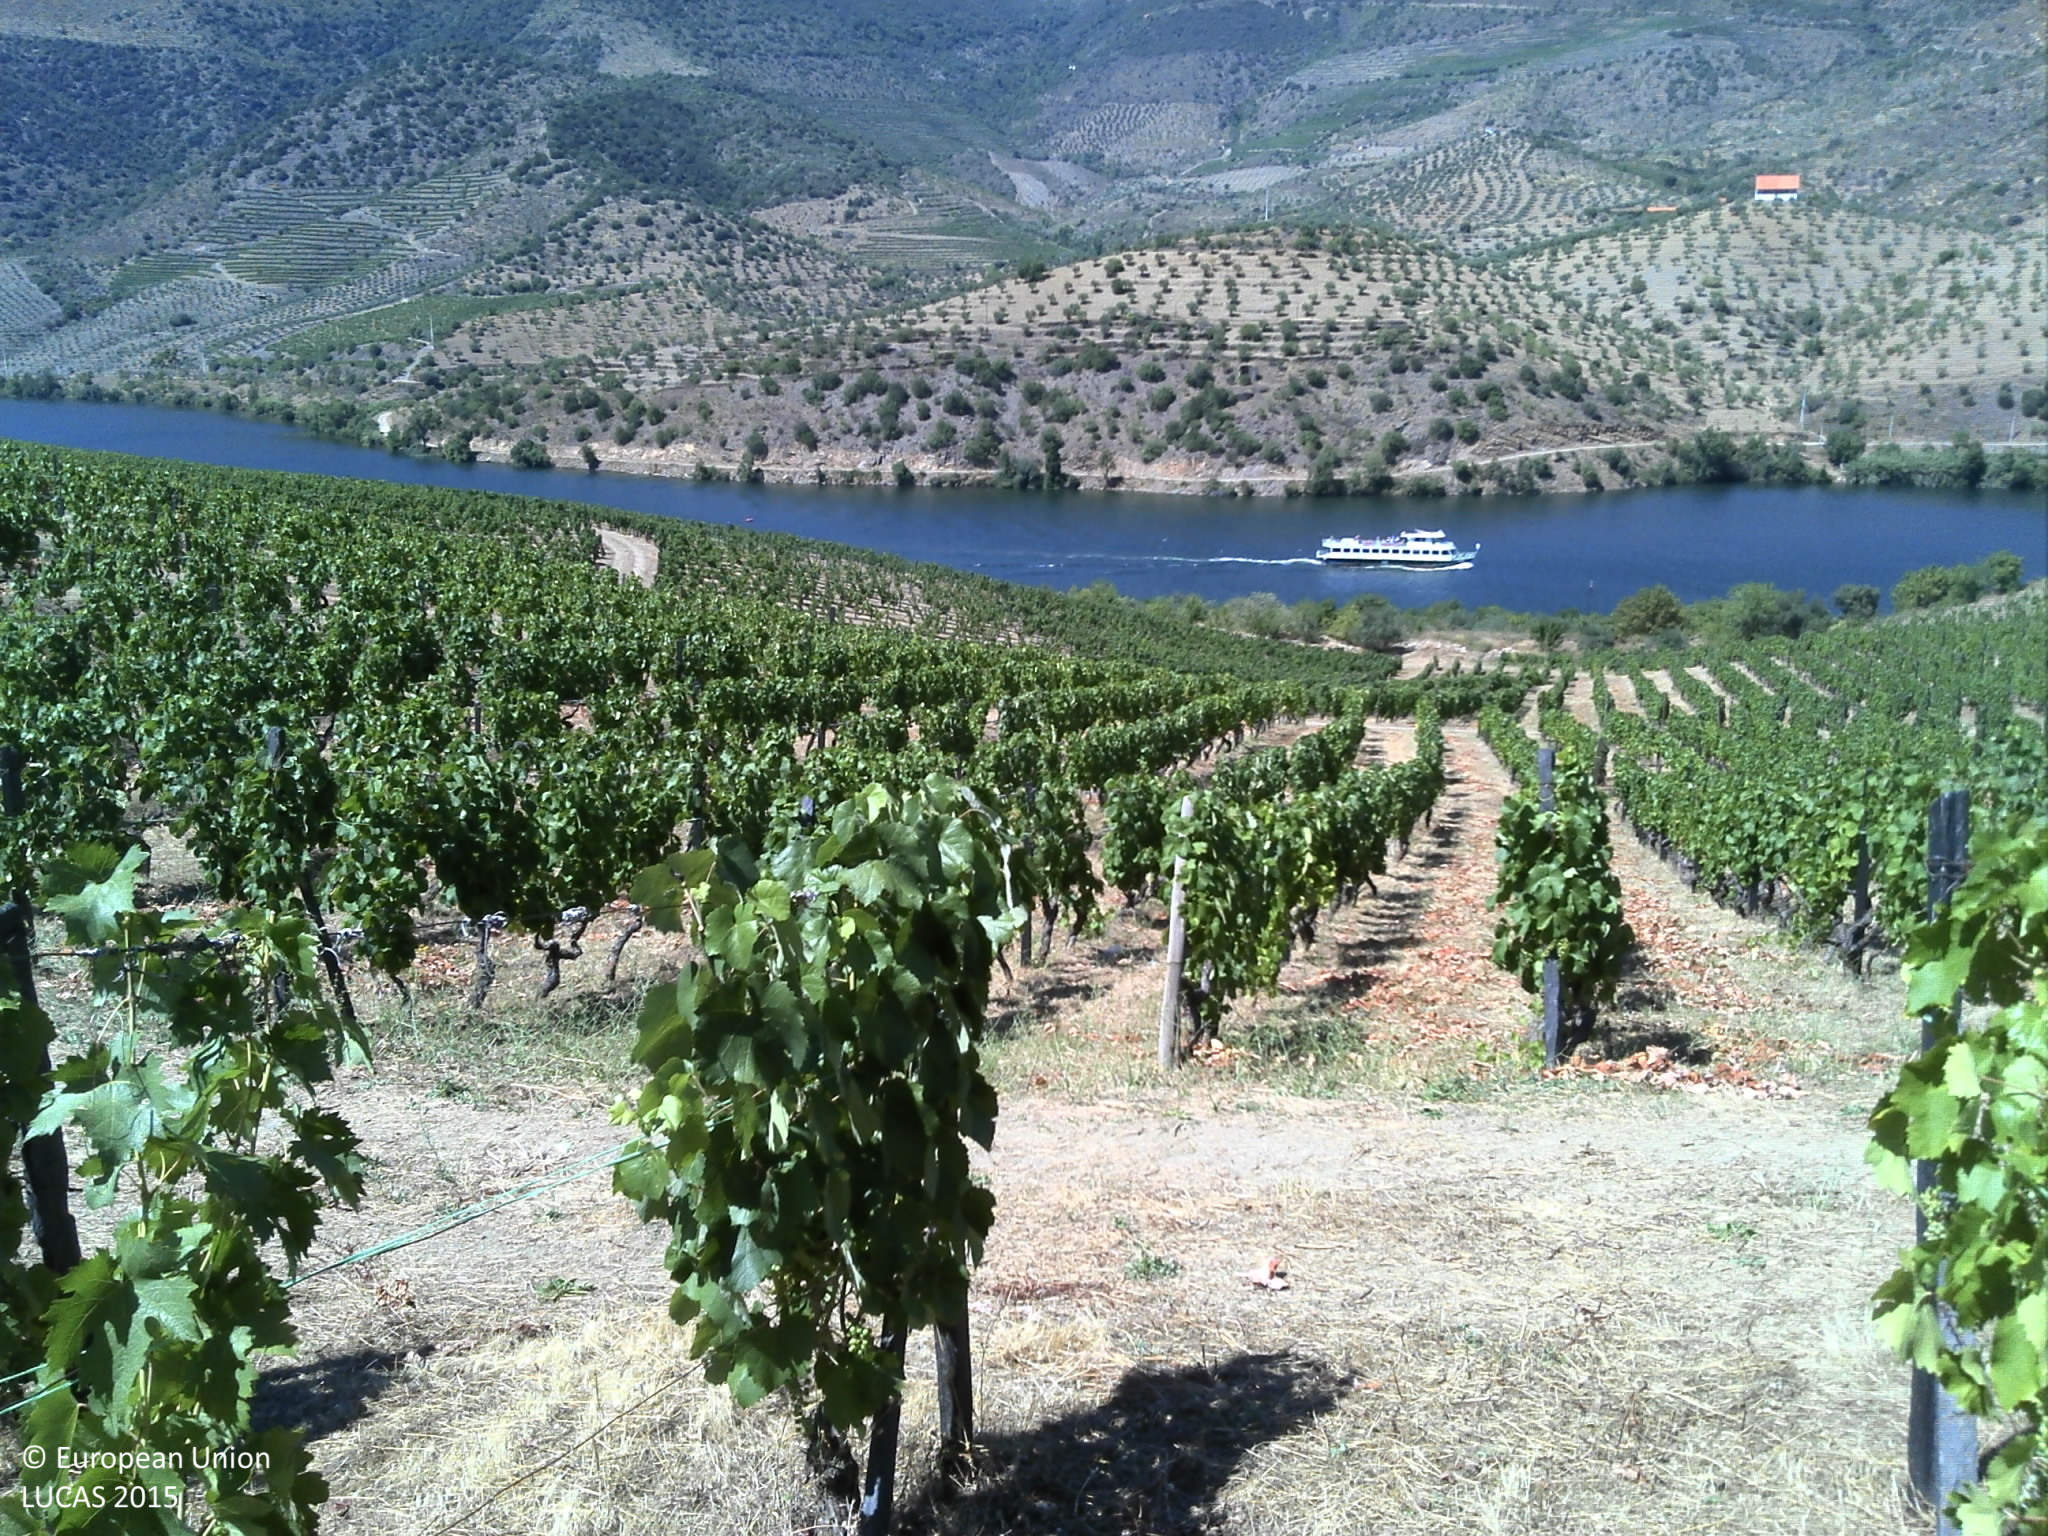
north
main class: Cropland
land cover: Vineyards
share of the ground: 10 - 25 %
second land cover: Grassland without tree/shrub cover
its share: > 75 %
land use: Agriculture (excluding fallow land and kitchen gardens)
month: June
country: PT
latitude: 41.0273
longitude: -6.9593
